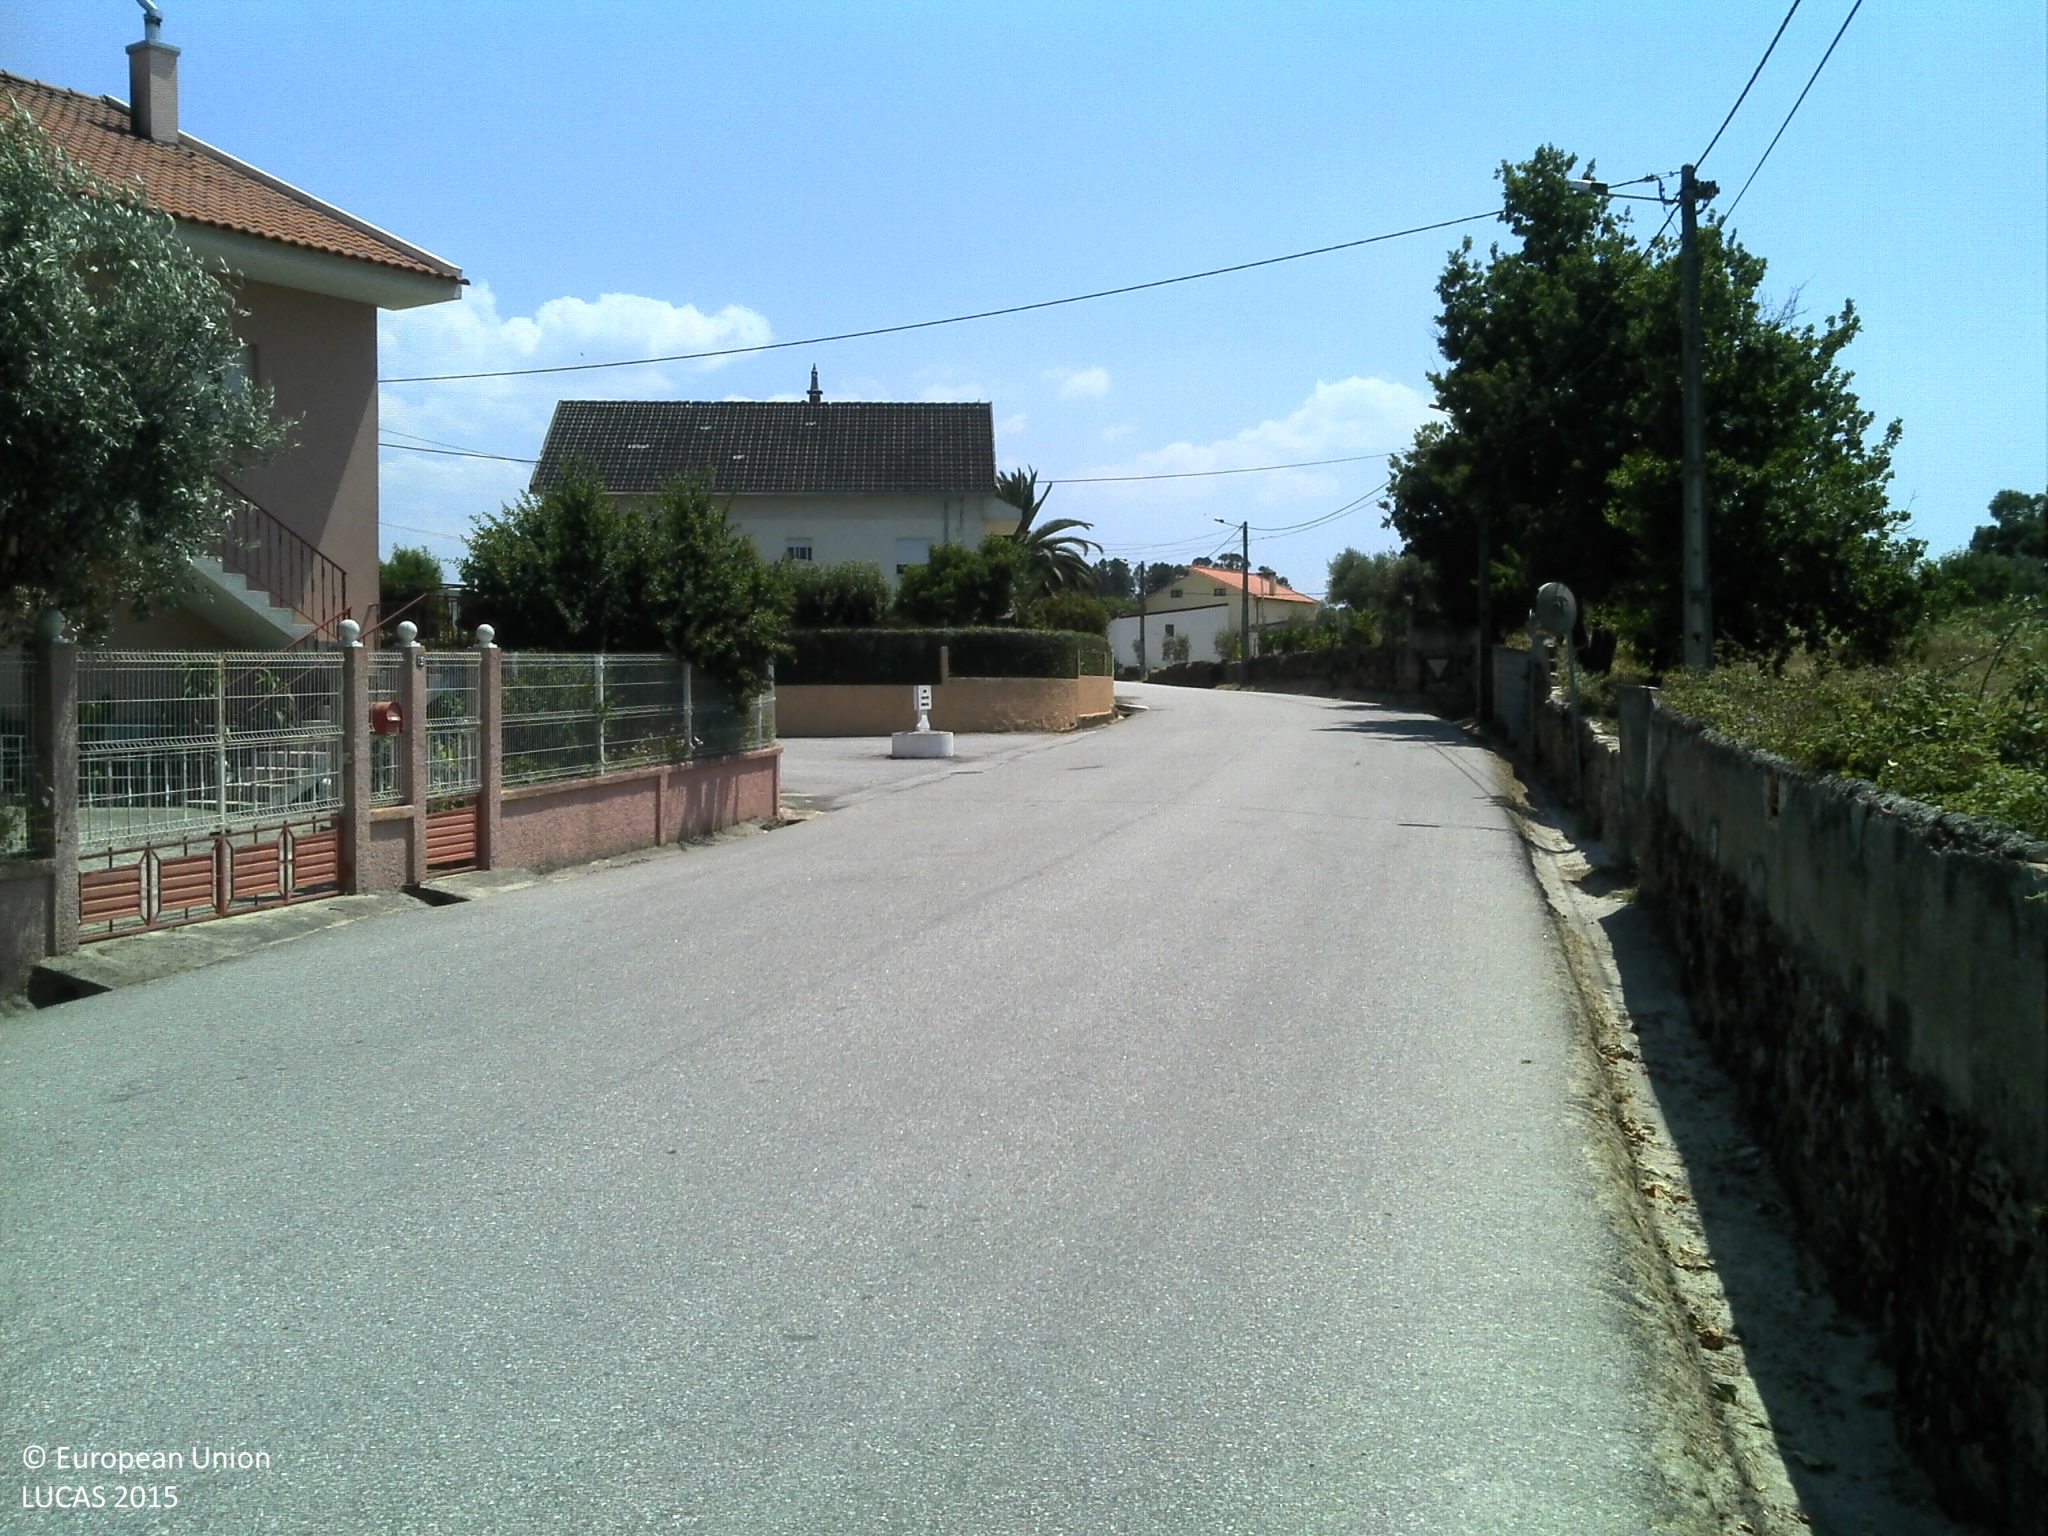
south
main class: Woodland
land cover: Broadleaved woodland
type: non-riverine alder, birch or aspen forest
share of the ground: 25 - 50 %
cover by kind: herbaceous plants 45 %, broadleaved forest trees 40 %, unconsolidated bare surface 15 %
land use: Forestry
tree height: > 5 m
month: June
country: PT
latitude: 40.4761
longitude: -7.7756
